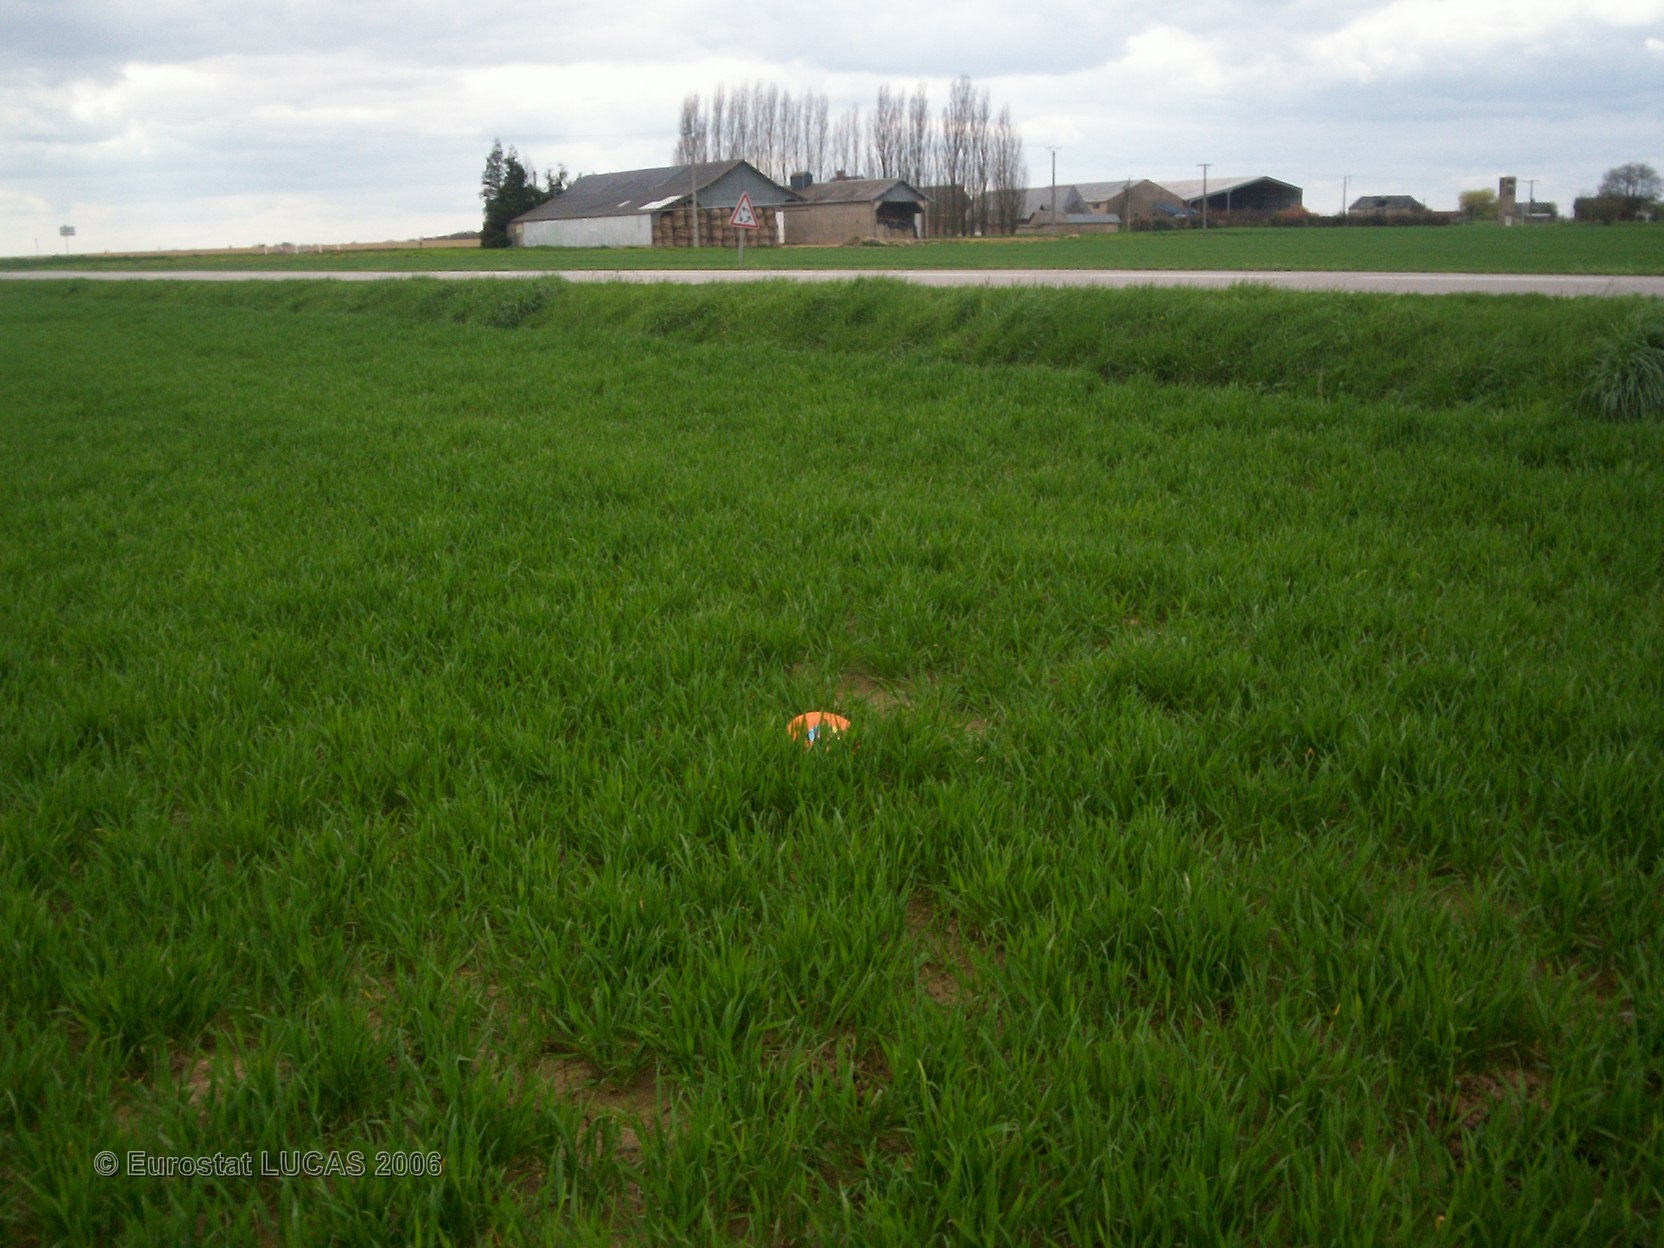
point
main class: Cropland
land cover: Common wheat
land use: Agriculture (excluding fallow land and kitchen gardens)
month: April
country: FR
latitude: 49.1578
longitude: 0.9965
